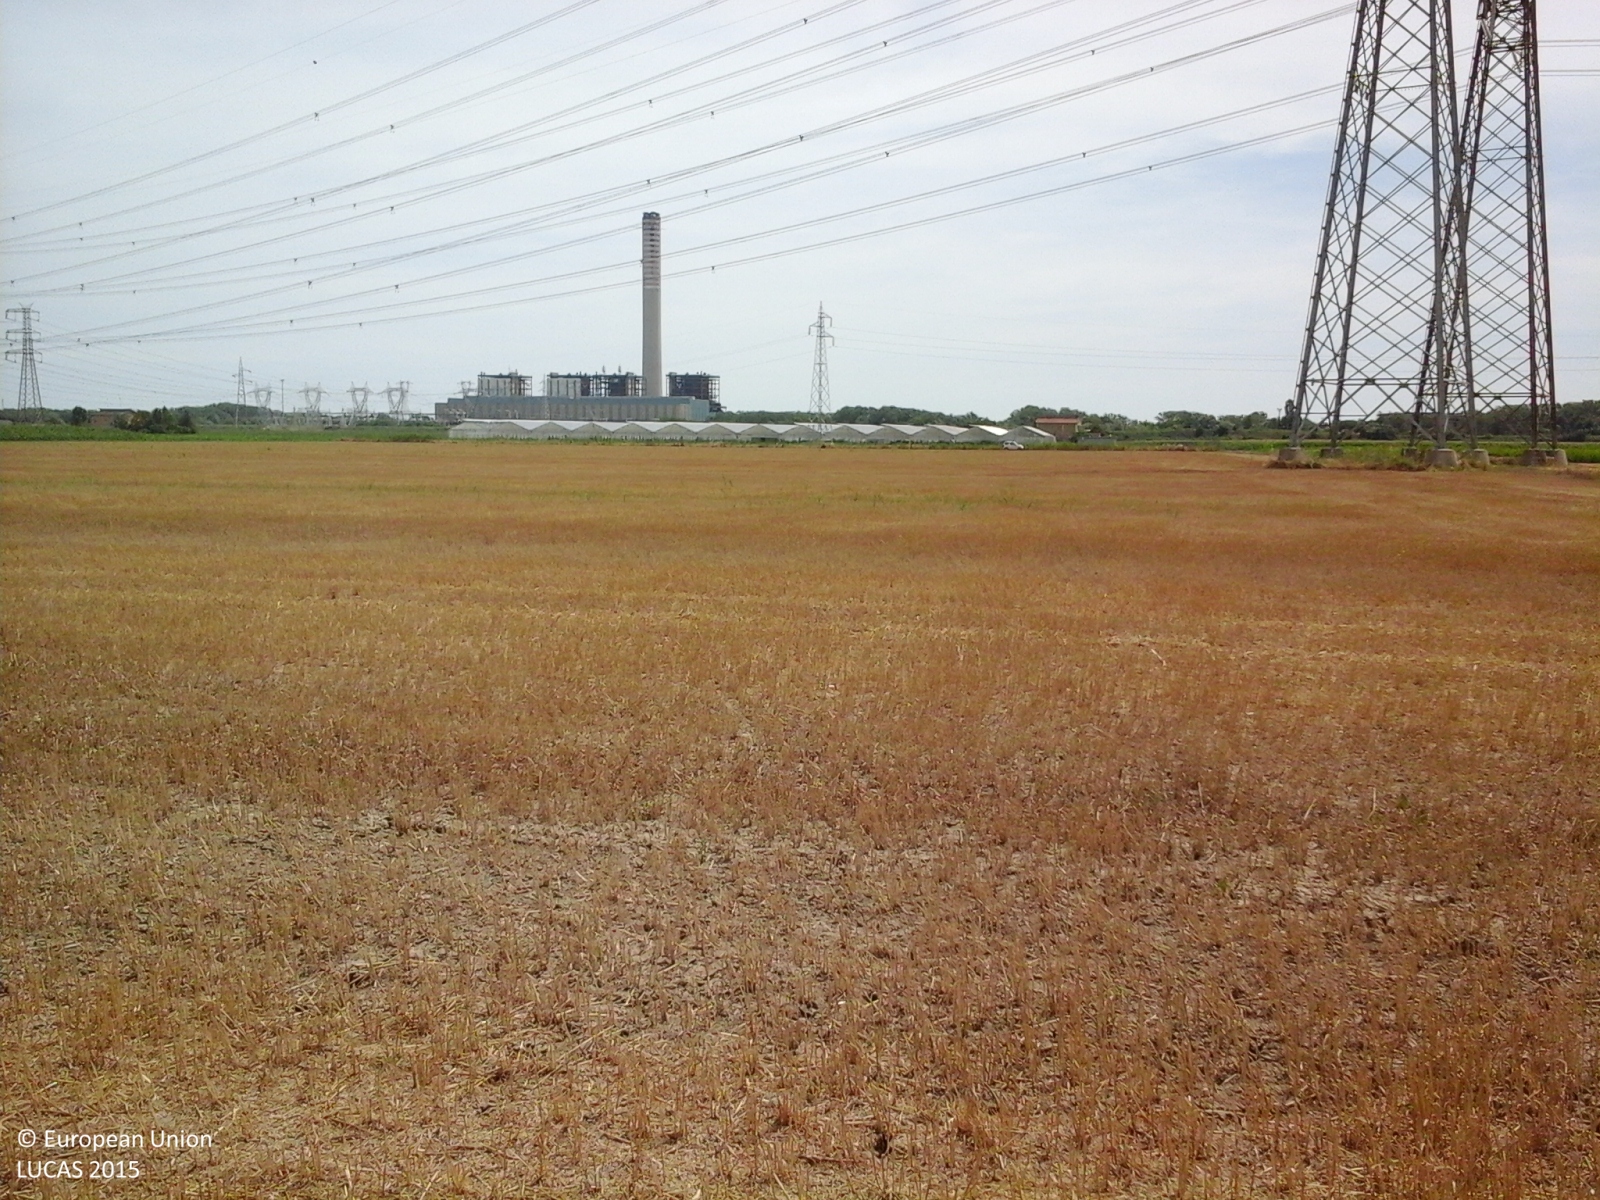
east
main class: Cropland
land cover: Common wheat
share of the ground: > 75 %
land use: Agriculture (excluding fallow land and kitchen gardens)
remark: Harvested field
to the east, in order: Common wheat; Electric lines; Common wheat; Electric lines; Common wheat
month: June
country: IT
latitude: 44.9526
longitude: 12.4673
